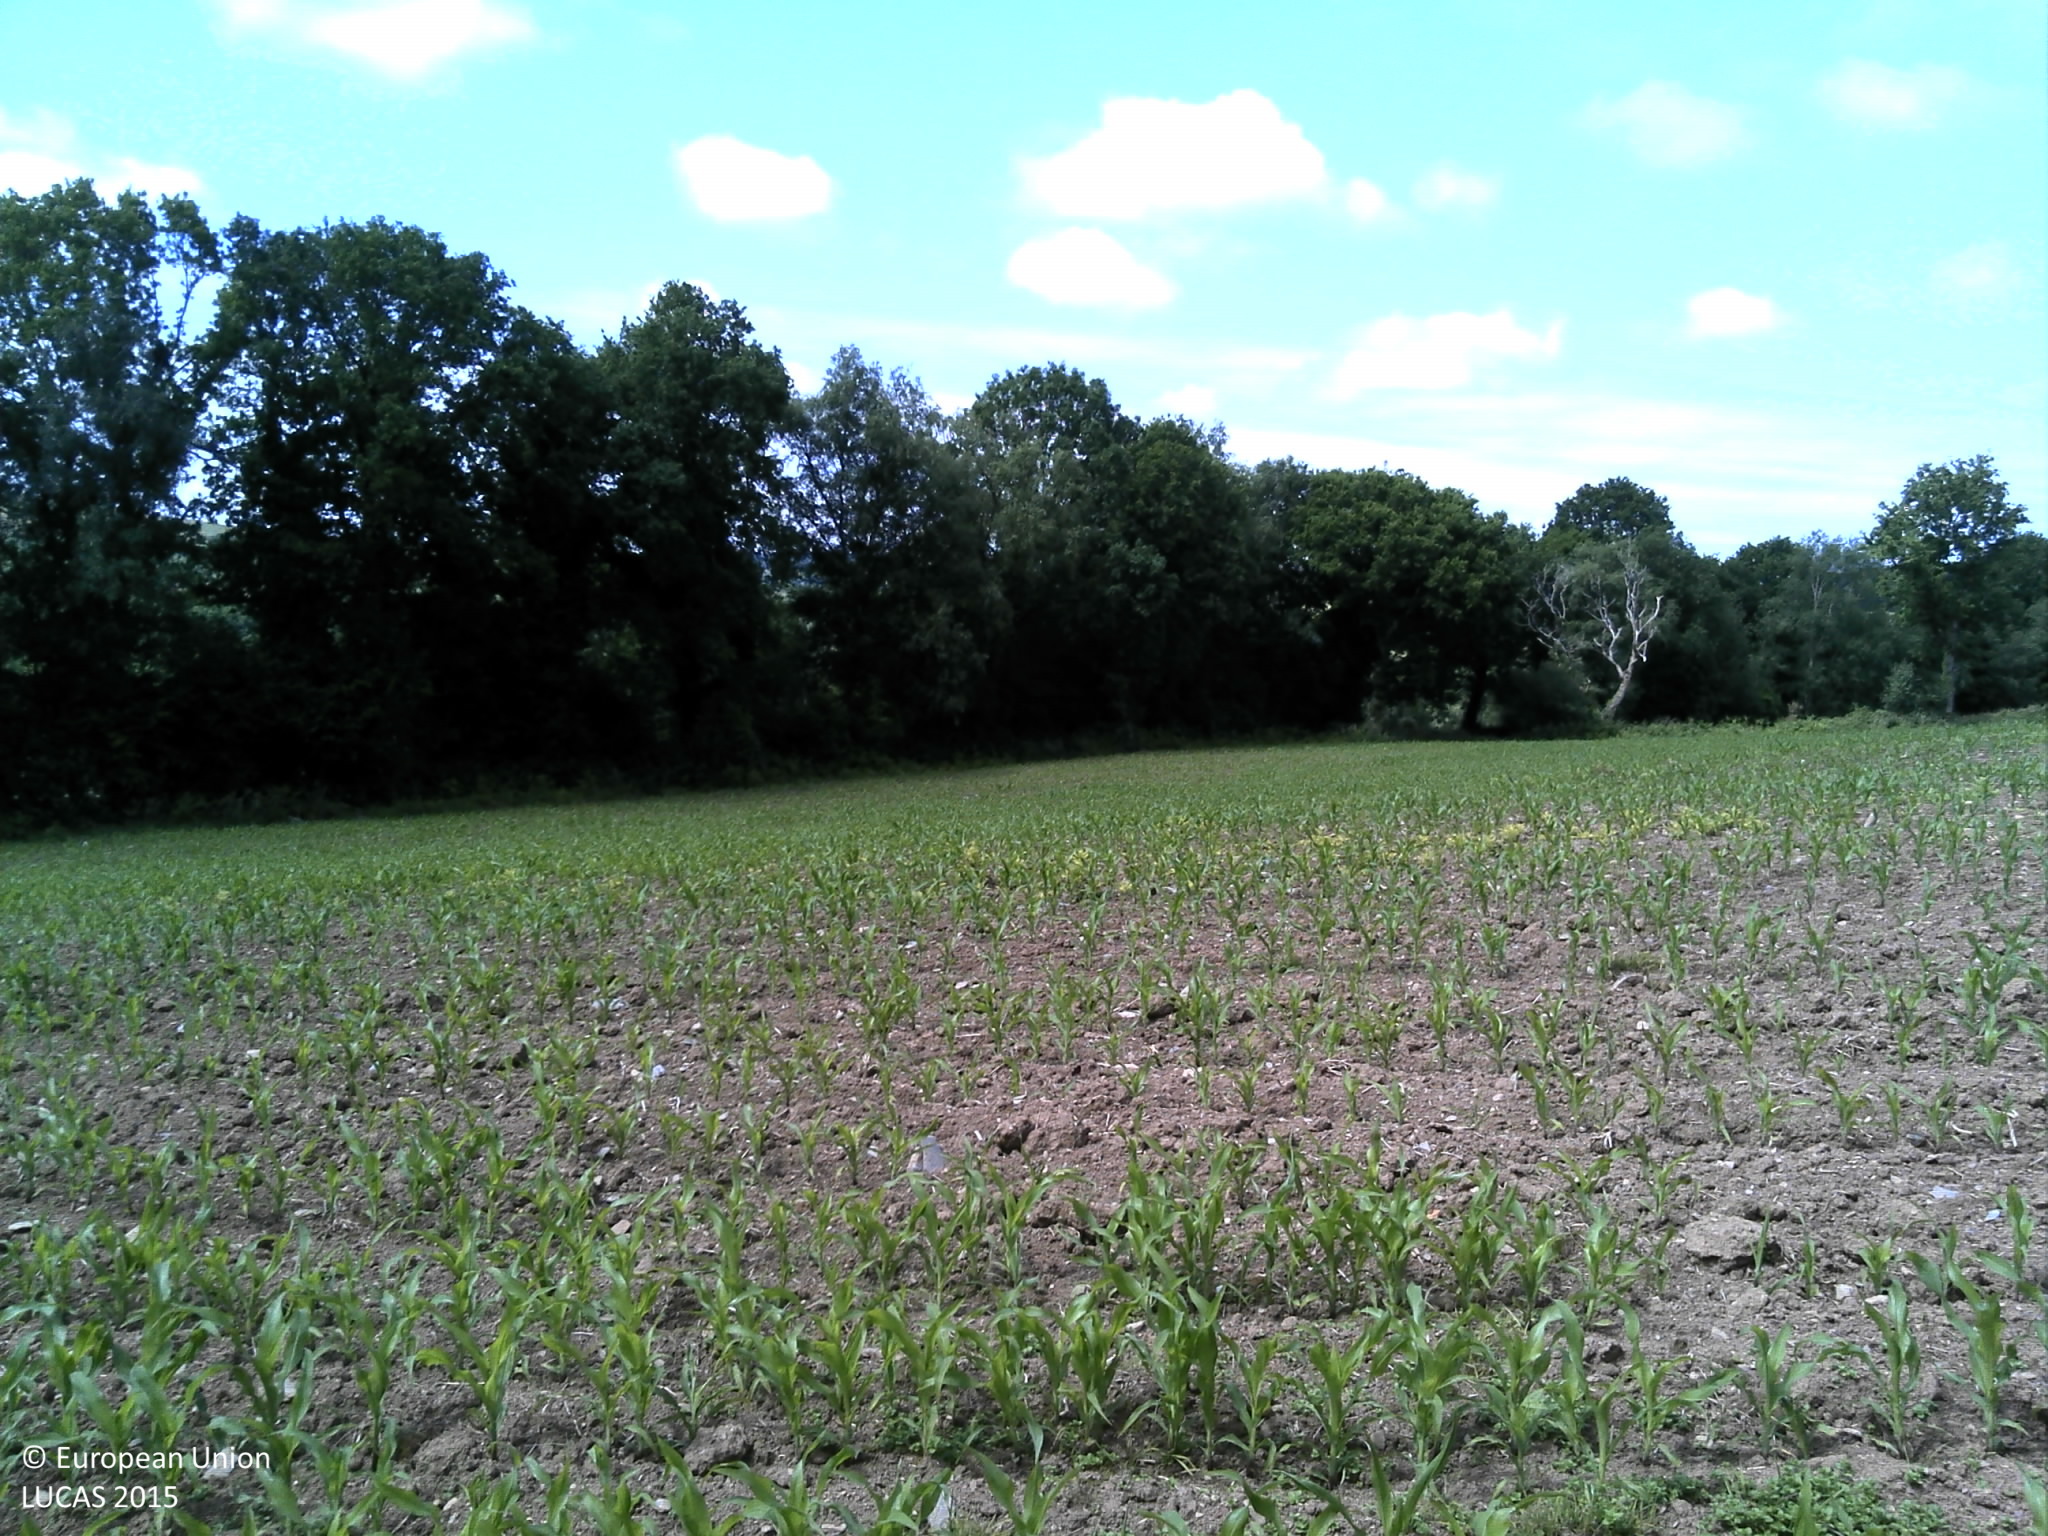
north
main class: Cropland
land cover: Maize
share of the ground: 10 - 25 %
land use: Agriculture (excluding fallow land and kitchen gardens)
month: June
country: FR
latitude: 48.4372
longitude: -3.7216
